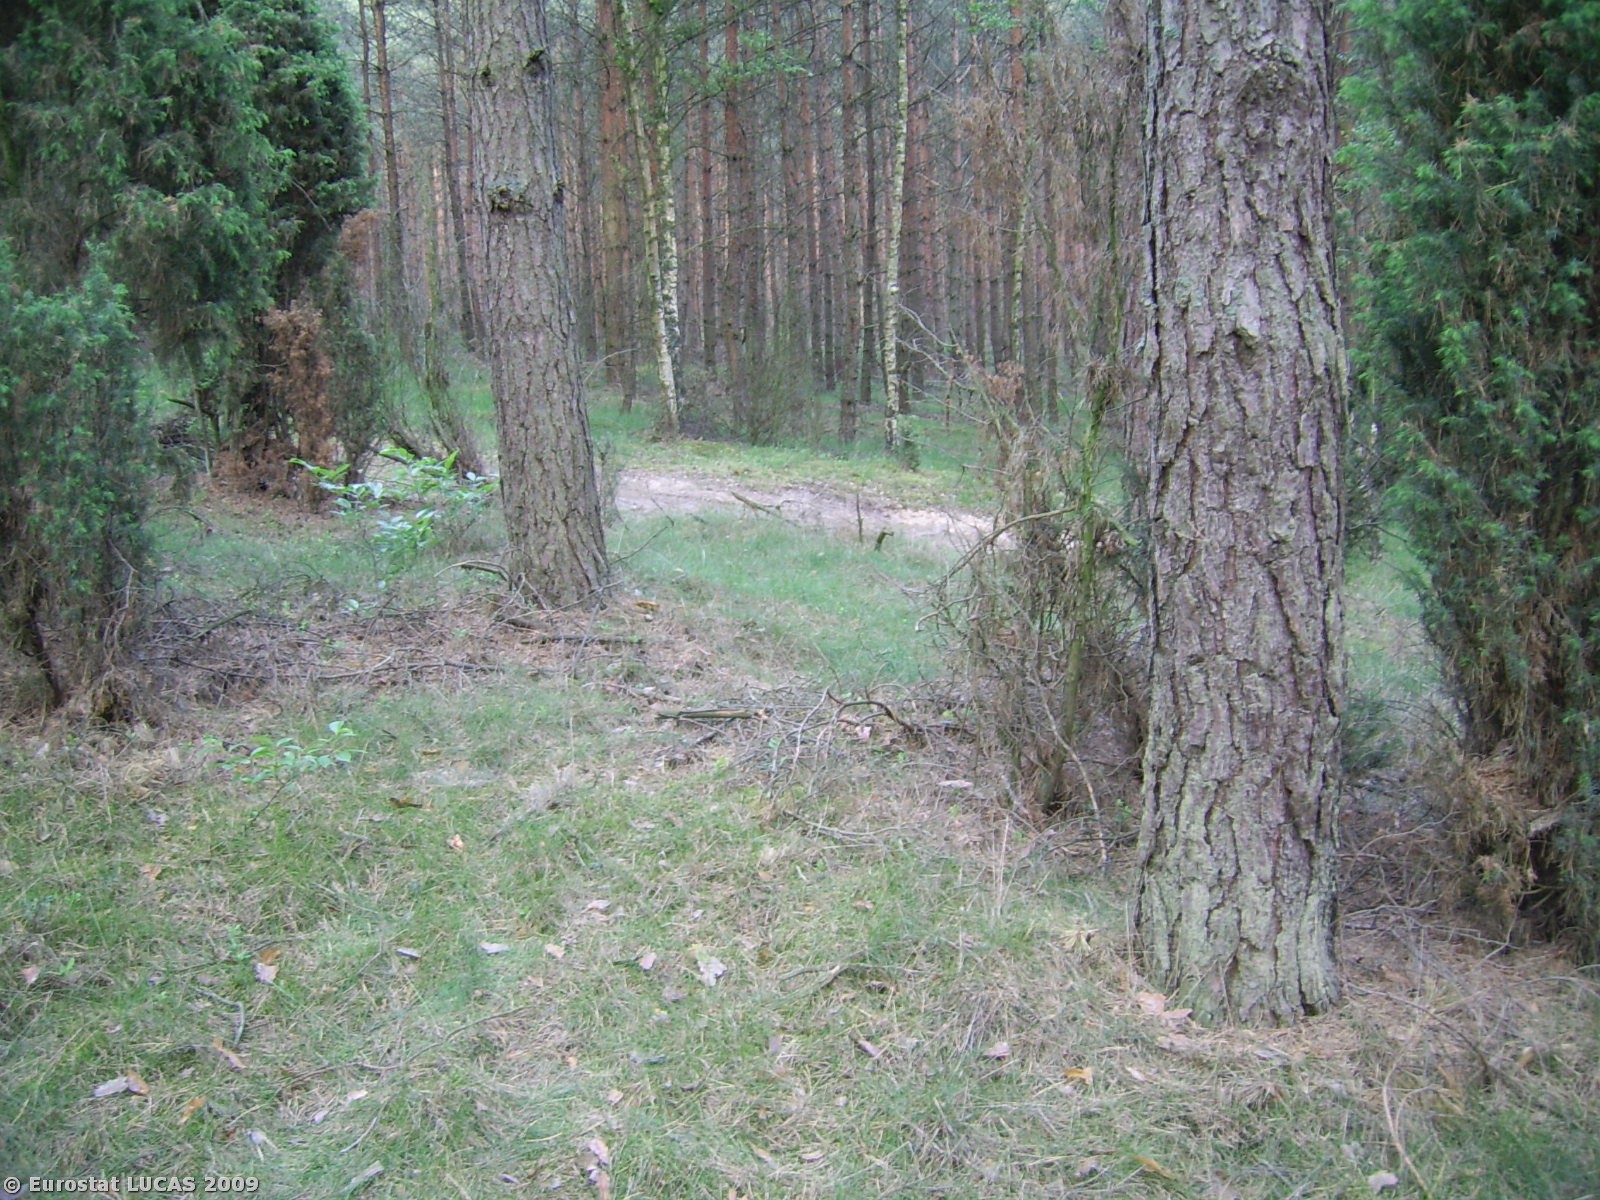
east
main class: Woodland
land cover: Coniferous woodland
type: hemiboreal forest and nemoral coniferous forest and mixed broadleaved-coniferous forest
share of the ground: > 75 %
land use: Forestry
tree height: > 5 m
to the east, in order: Coniferous woodland; Paved roads, cycling and walking lanes; Coniferous woodland
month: May
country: PL
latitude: 53.0450
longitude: 18.0253
